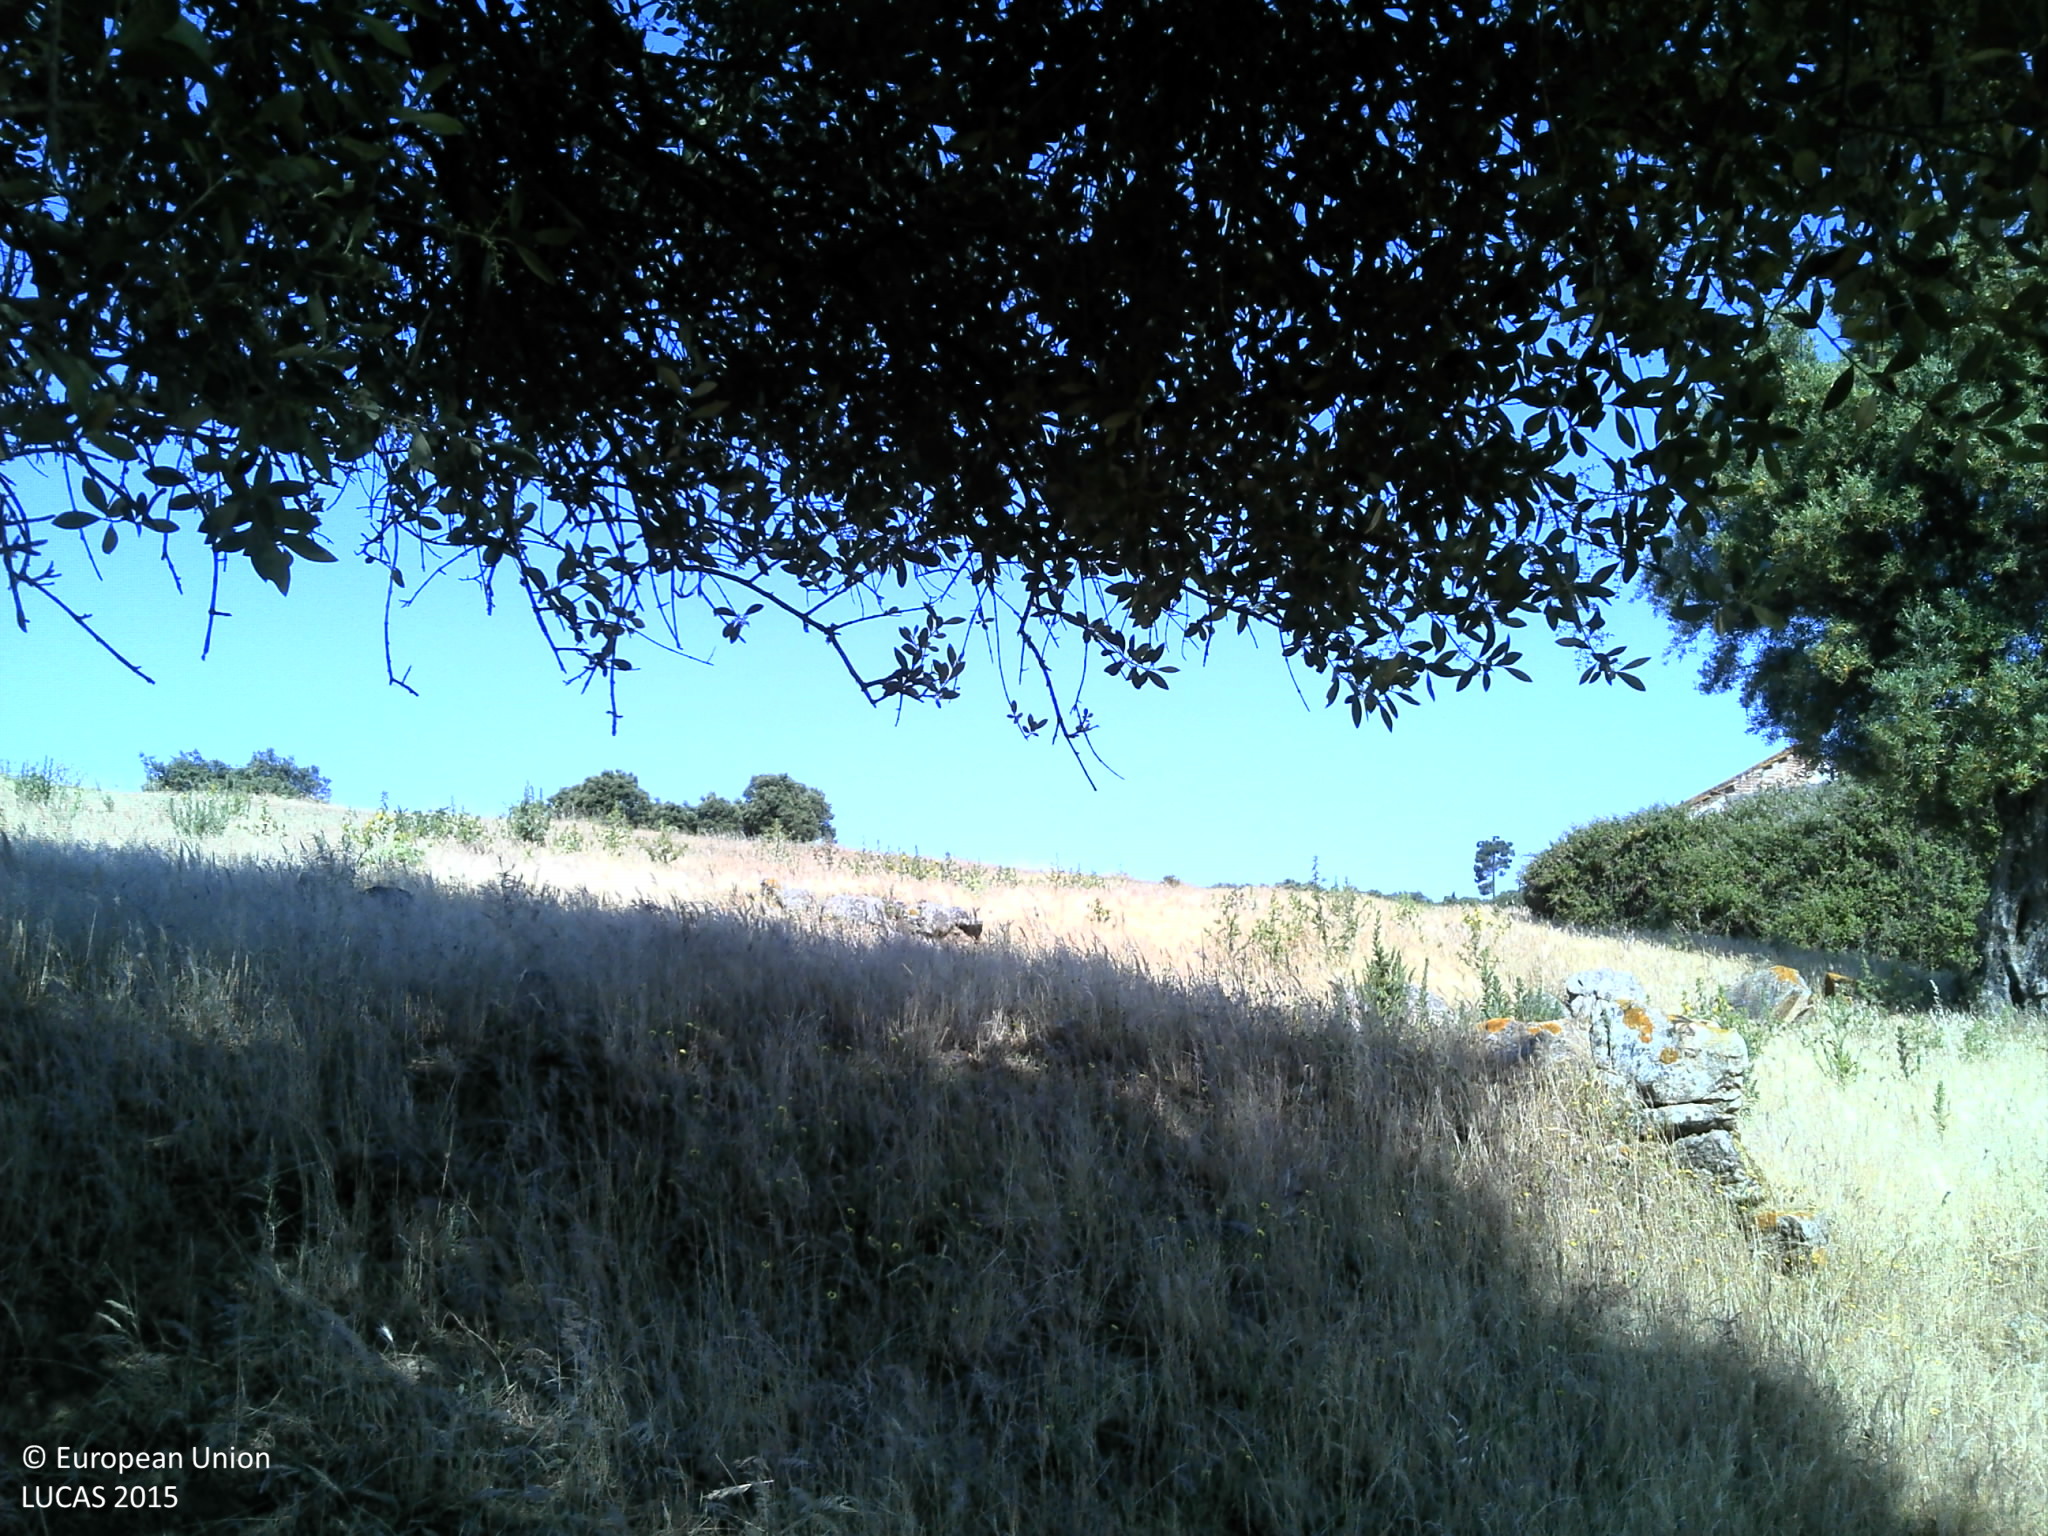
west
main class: Cropland
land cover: Olive groves
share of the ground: 10 - 25 %
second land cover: Grassland without tree/shrub cover
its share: > 75 %
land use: Agriculture (excluding fallow land and kitchen gardens)
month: June
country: PT
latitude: 38.6998
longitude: -8.0871
